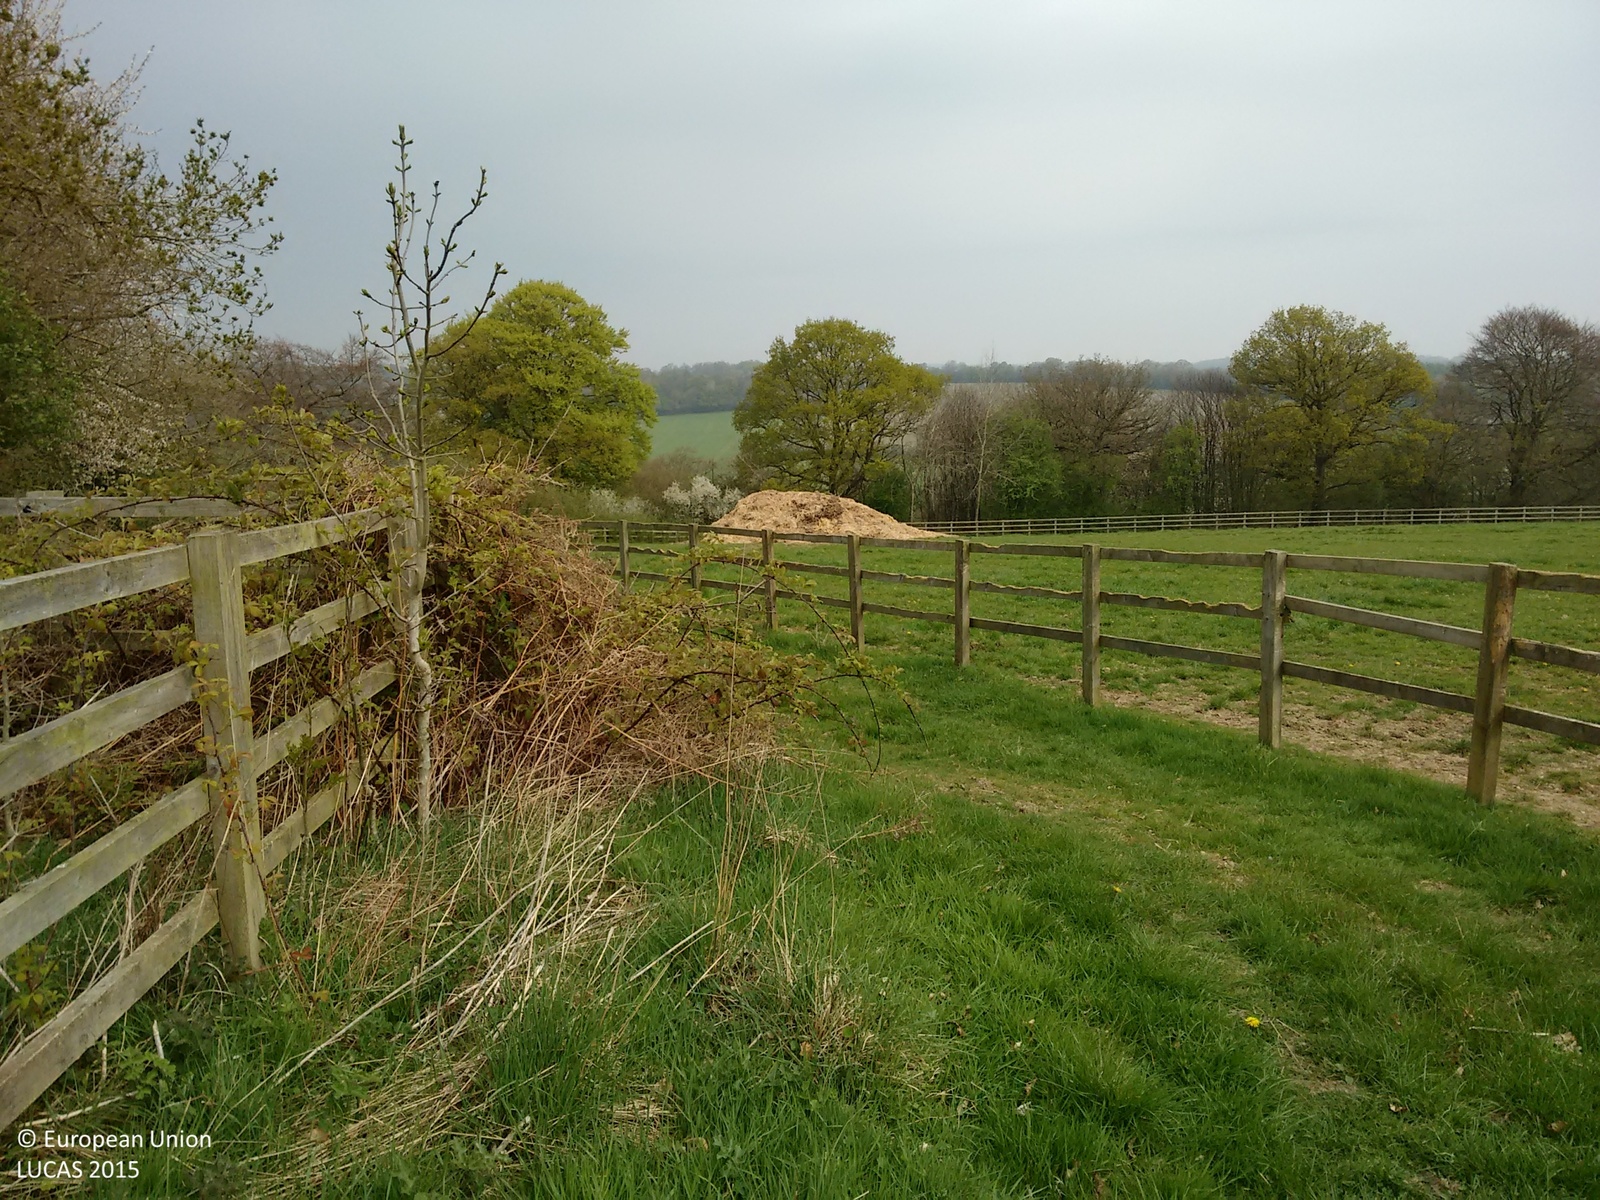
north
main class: Grassland
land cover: Grassland without tree/shrub cover
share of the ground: > 75 %
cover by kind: herbaceous plants 100 %
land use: Agriculture (excluding fallow land and kitchen gardens)
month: April
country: GB
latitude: 51.7077
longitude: -0.7356
